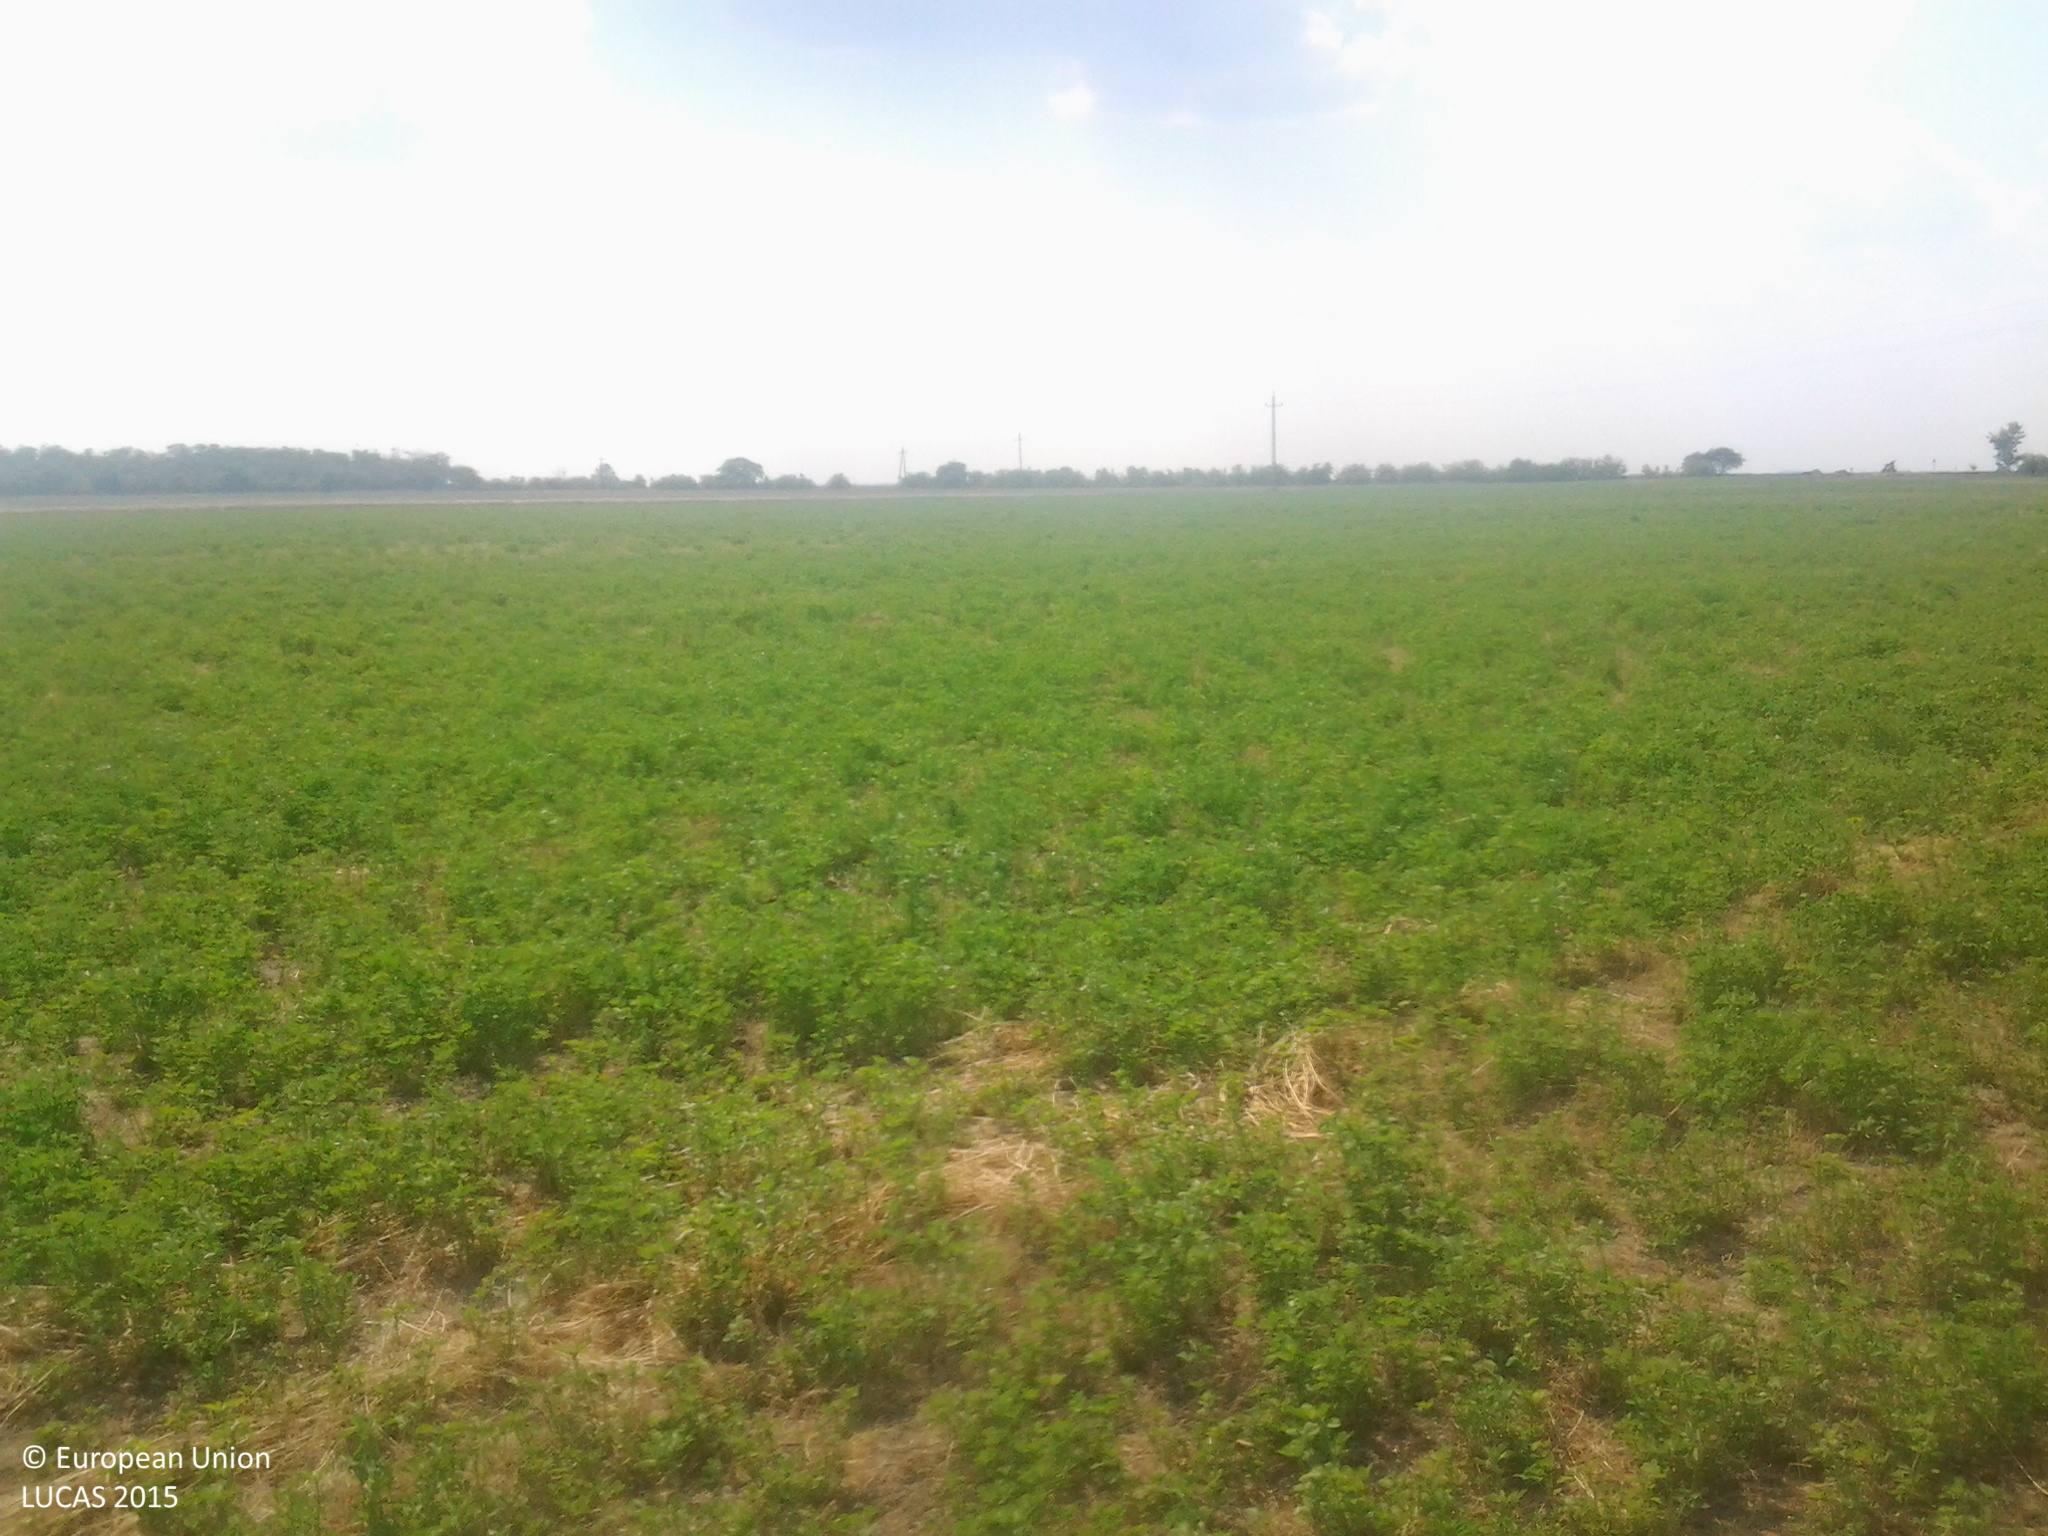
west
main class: Cropland
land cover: Lucerne
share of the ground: > 75 %
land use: Agriculture (excluding fallow land and kitchen gardens)
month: July
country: HU
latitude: 47.0553
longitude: 19.2461
